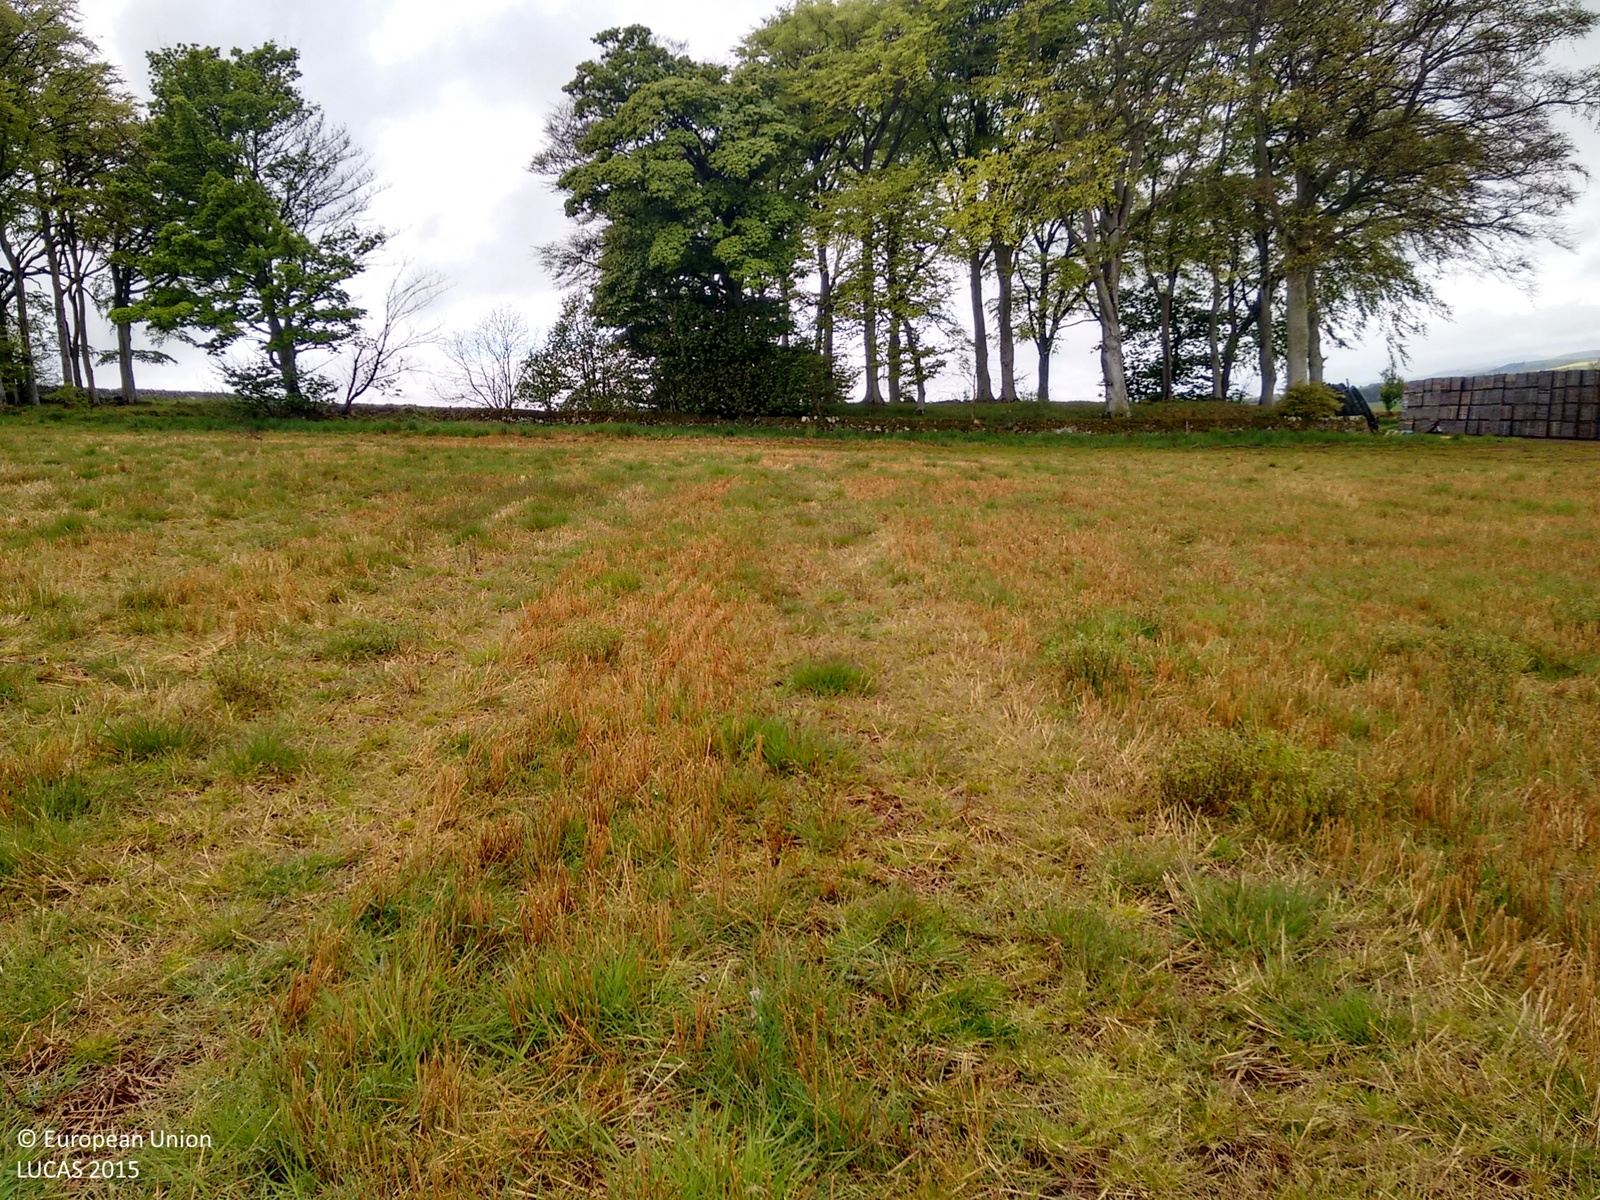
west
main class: Grassland
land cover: Grassland without tree/shrub cover
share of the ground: > 75 %
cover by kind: herbaceous plants 100 %
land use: Agriculture (excluding fallow land and kitchen gardens)
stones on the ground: 10 - 25 %
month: May
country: GB
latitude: 56.6215
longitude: -2.5910
